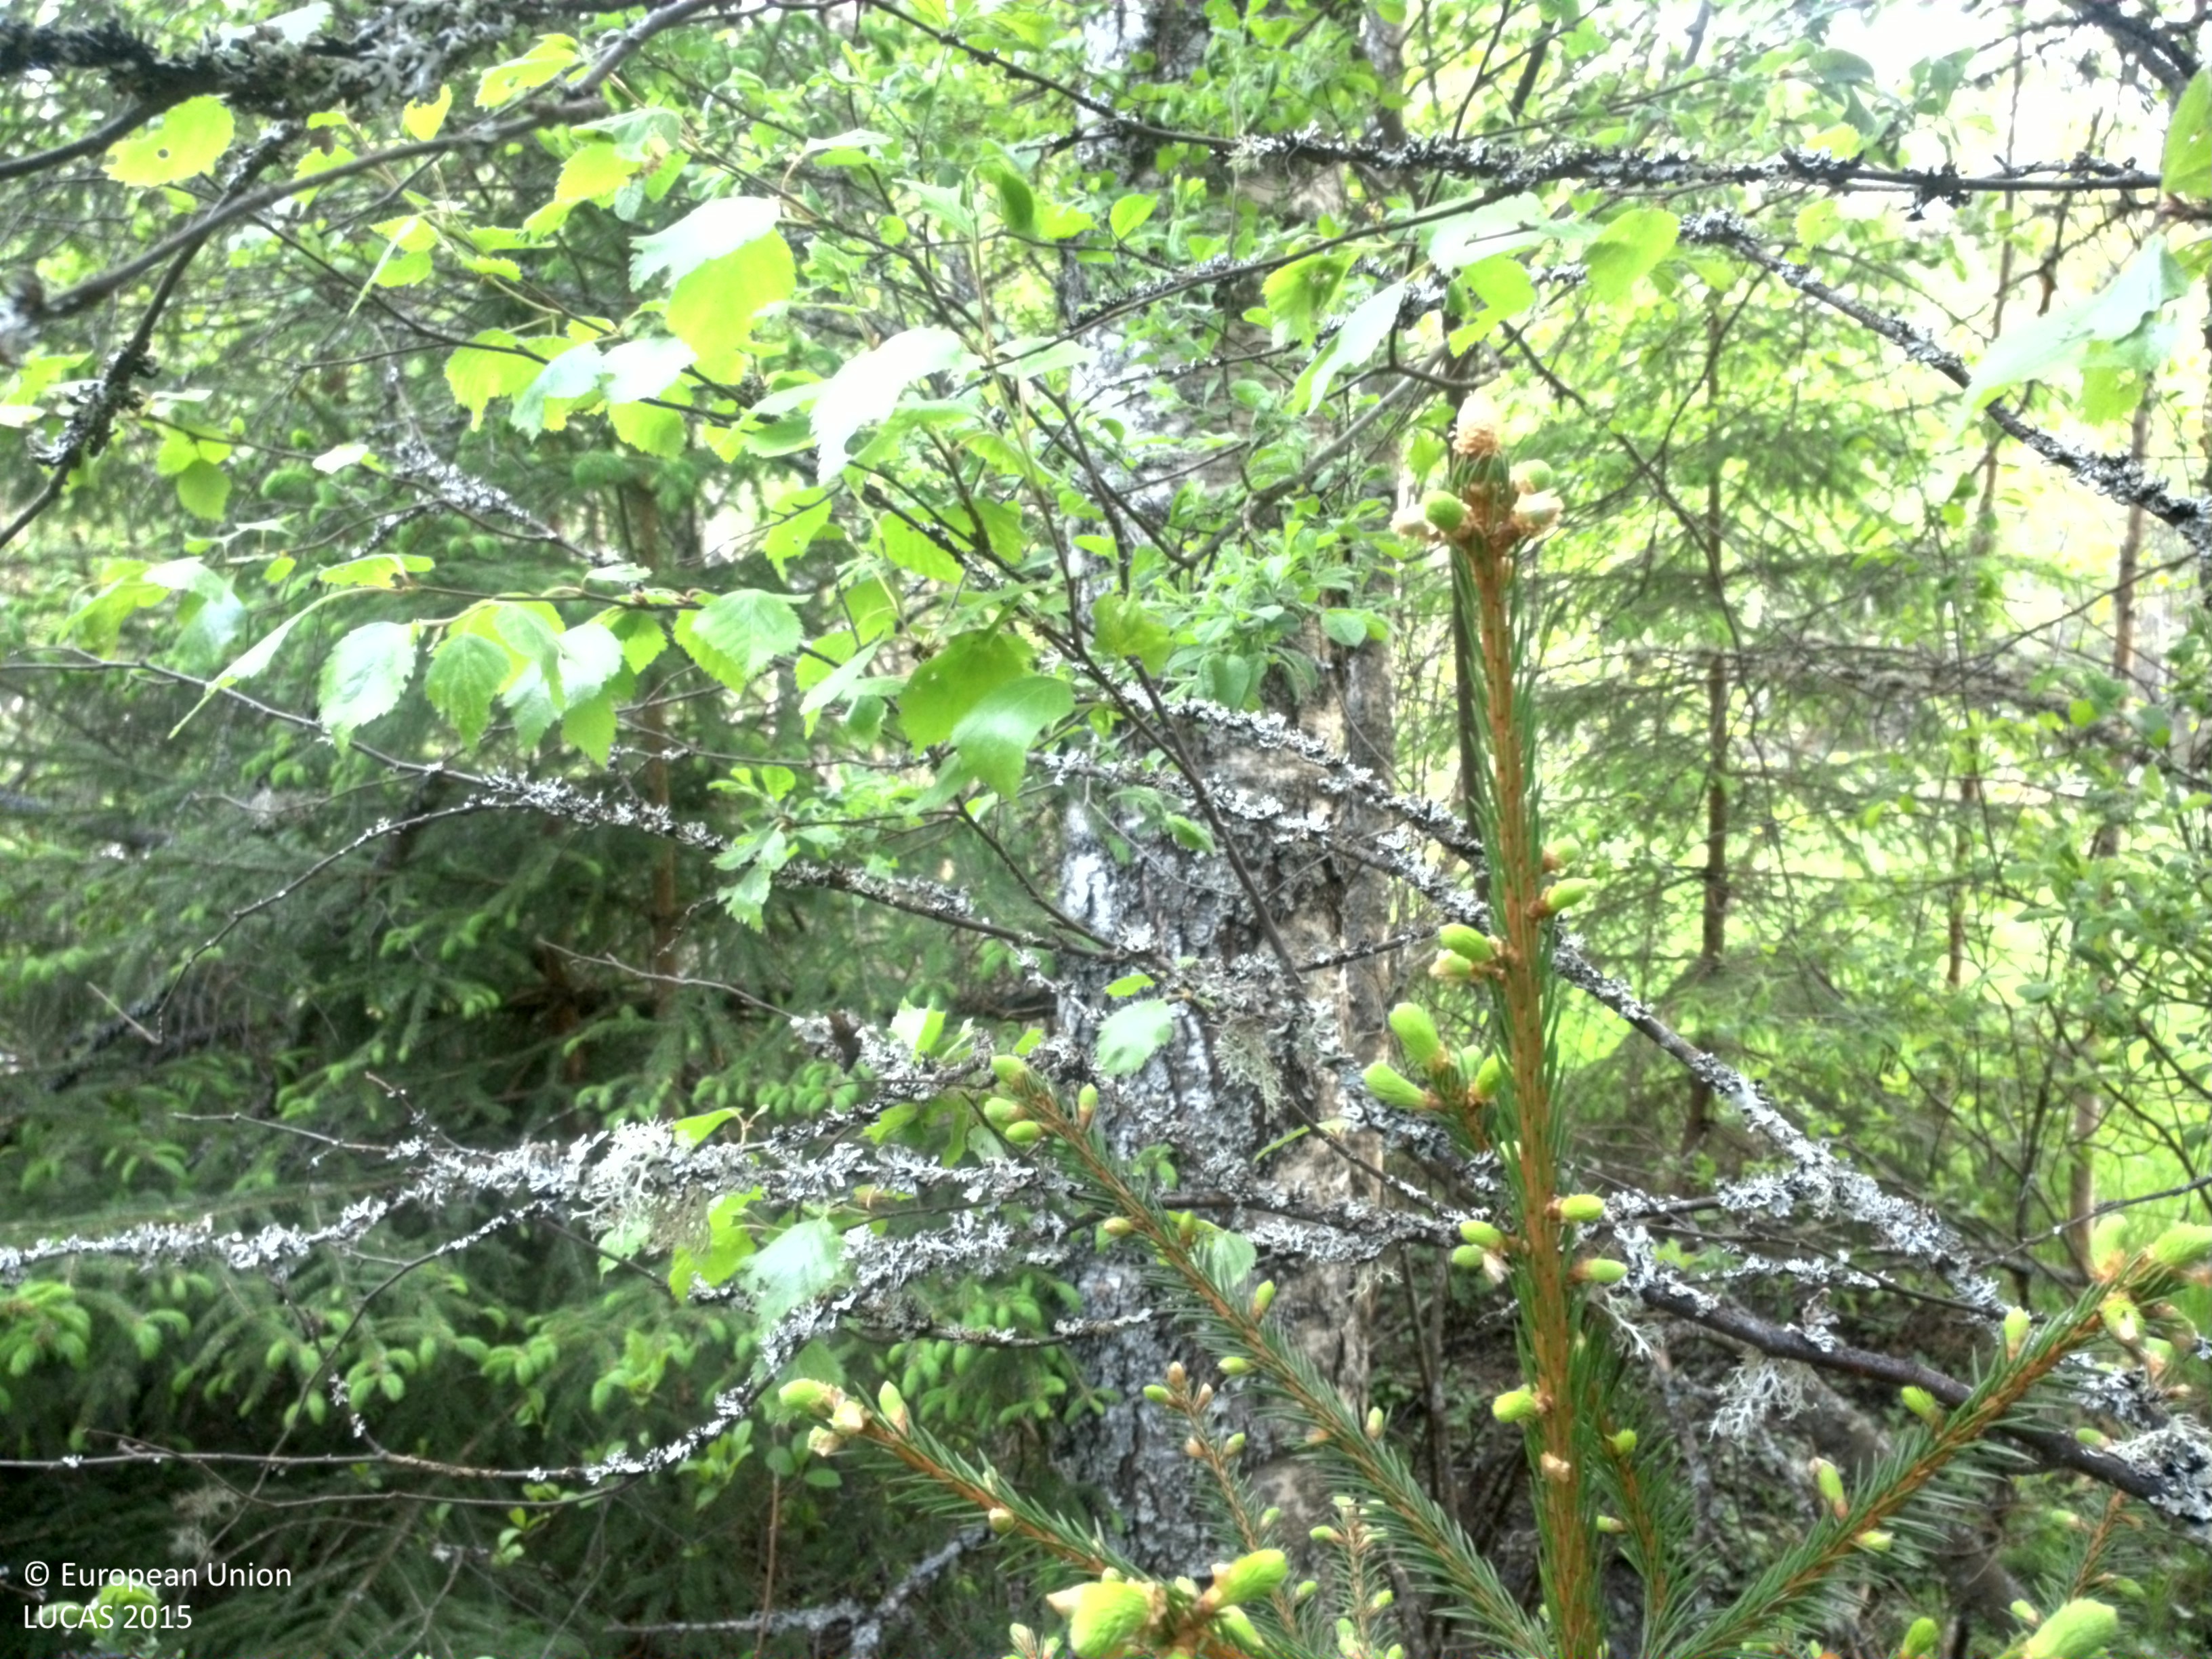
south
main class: Woodland
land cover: Broadleaved woodland
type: boreal forest
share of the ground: 50 - 75 %
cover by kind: broadleaved forest trees 50 %, herbaceous plants 15 %, lichens and mosses 15 %, coniferous forest trees 10 %, shrubs 10 %
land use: Forestry
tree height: > 5 m
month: May
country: SE
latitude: 57.3132
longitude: 15.9252
